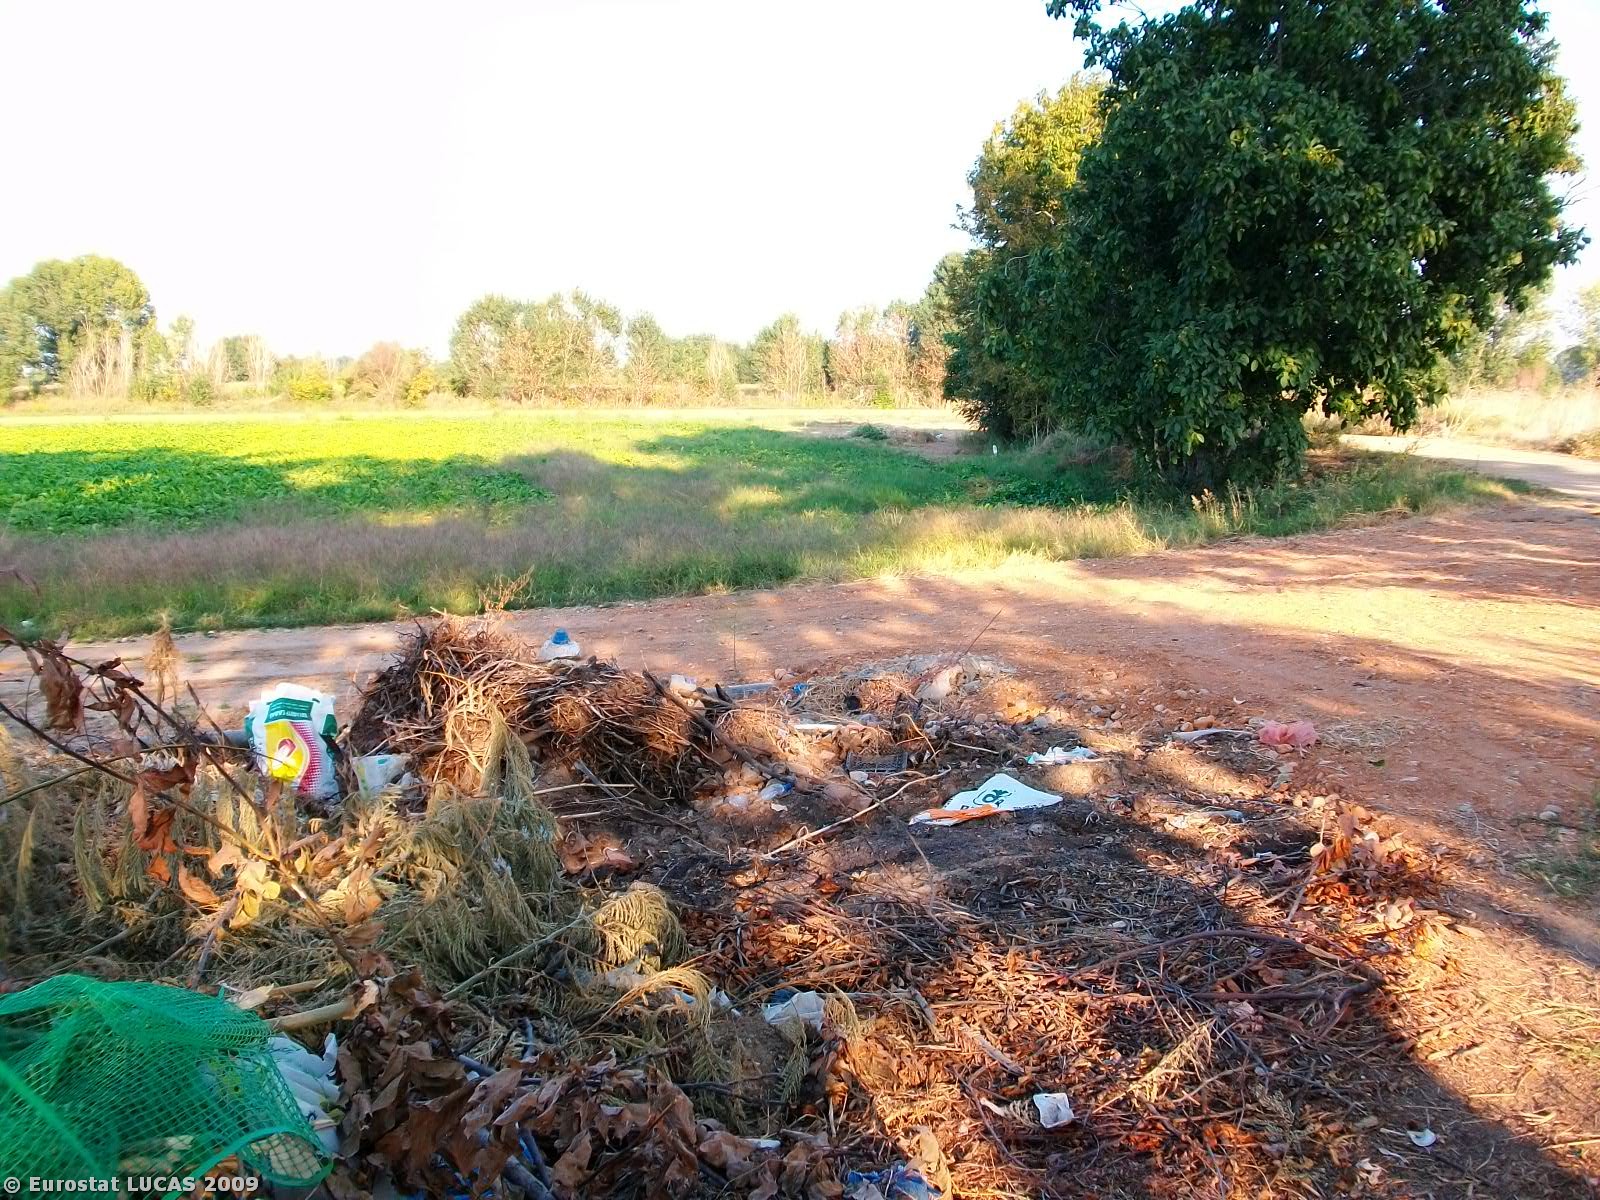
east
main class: Shrubland
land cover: Shrubland without tree cover
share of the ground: > 75 %
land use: Unused
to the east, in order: Shrubland without tree cover; Tracks; Sugar beet; Grass margins; Common wheat; Other fresh vegetables; Abandoned hedges; Ditches and canals; Abandoned hedges; Tracks; Abandoned hedges; Maize
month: September
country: GR
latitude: 41.5761
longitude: 26.5481
